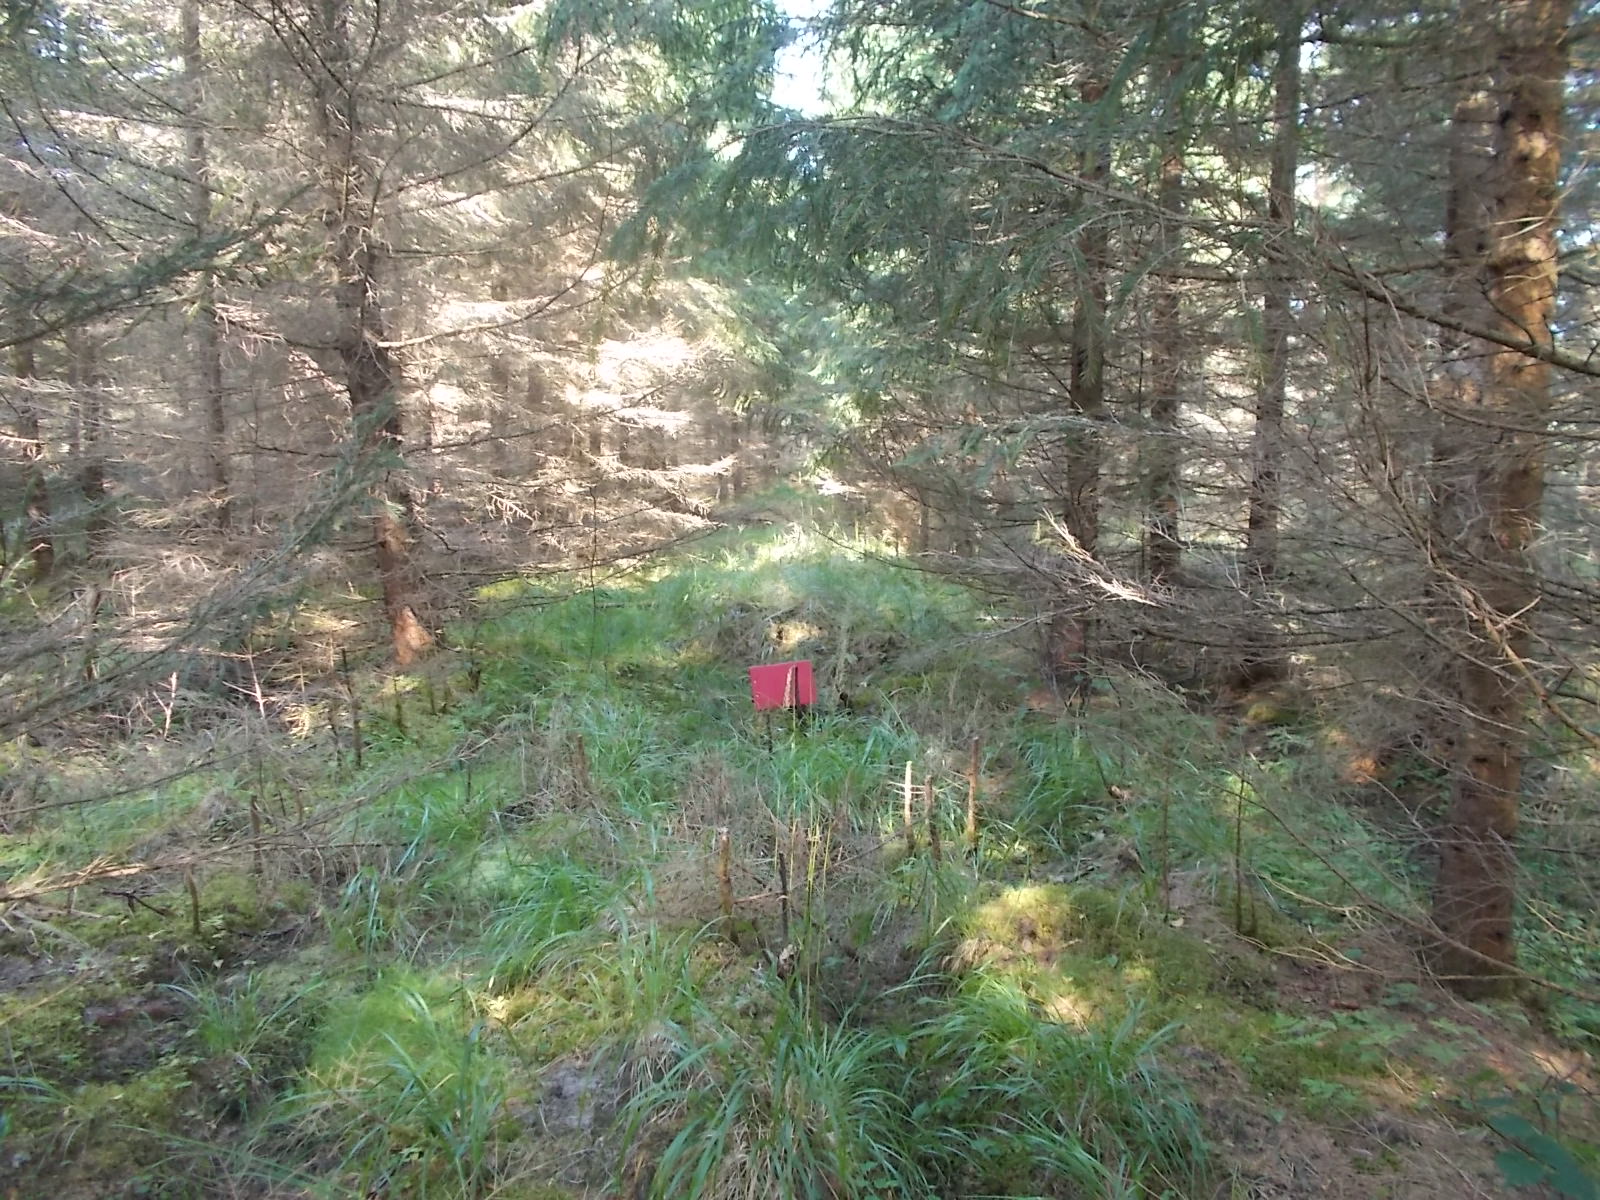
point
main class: Woodland
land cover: Spruce dominated coniferous woodland
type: hemiboreal forest and nemoral coniferous forest and mixed broadleaved-coniferous forest
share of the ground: 50 - 75 %
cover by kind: coniferous forest trees 70 %, shrubs 10 %, herbaceous plants 10 %, lichens and mosses 10 %
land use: Forestry
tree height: > 5 m
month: August
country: LV
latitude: 57.0541
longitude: 22.0668
